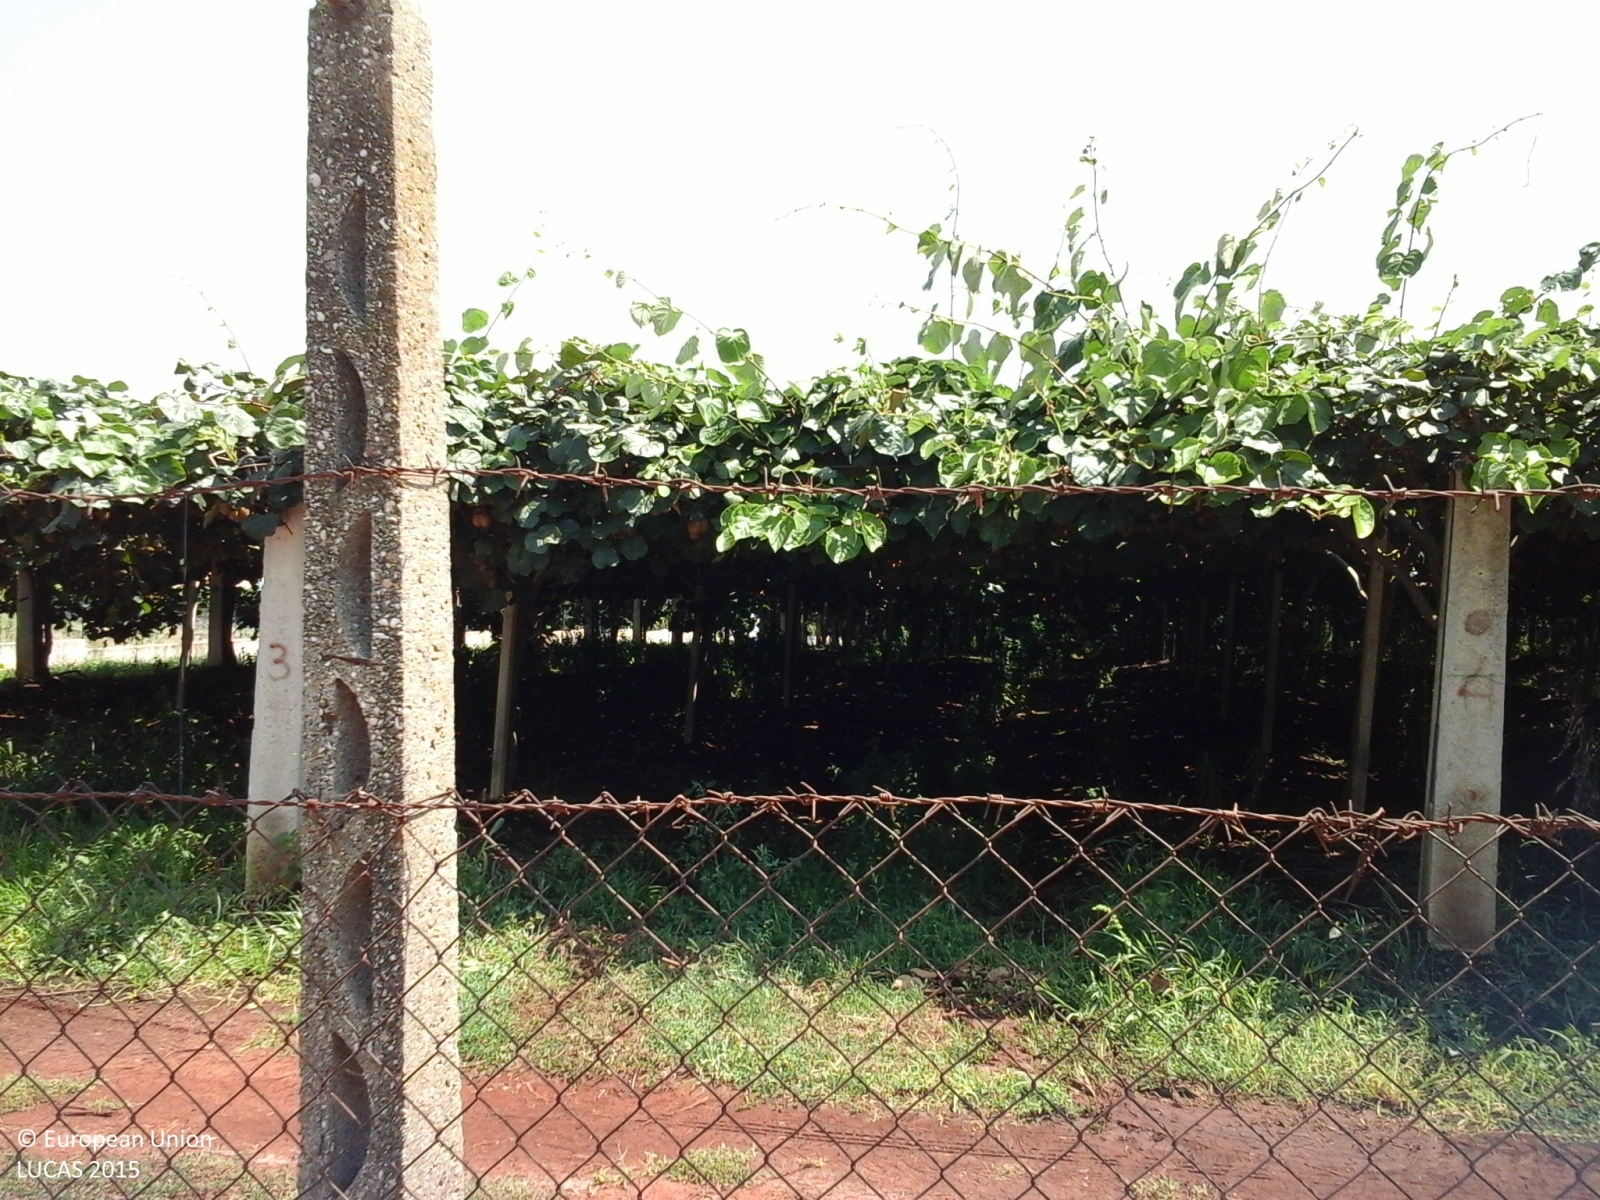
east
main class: Cropland
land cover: Other fruit trees and berries
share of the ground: > 75 %
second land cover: Grassland without tree/shrub cover
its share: > 75 %
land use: Agriculture (excluding fallow land and kitchen gardens)
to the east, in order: Other fruit trees and berries; Grassland without tree/shrub cover; Grassland with sparse tree/shrub cover; Tracks; Artificial constructions; Grassland with sparse tree/shrub cover; Artificial constructions in urban areas; Grassland without tree/shrub cover; Fences; Other fruit trees and berries
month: July
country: IT
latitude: 41.6027
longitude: 12.8087
